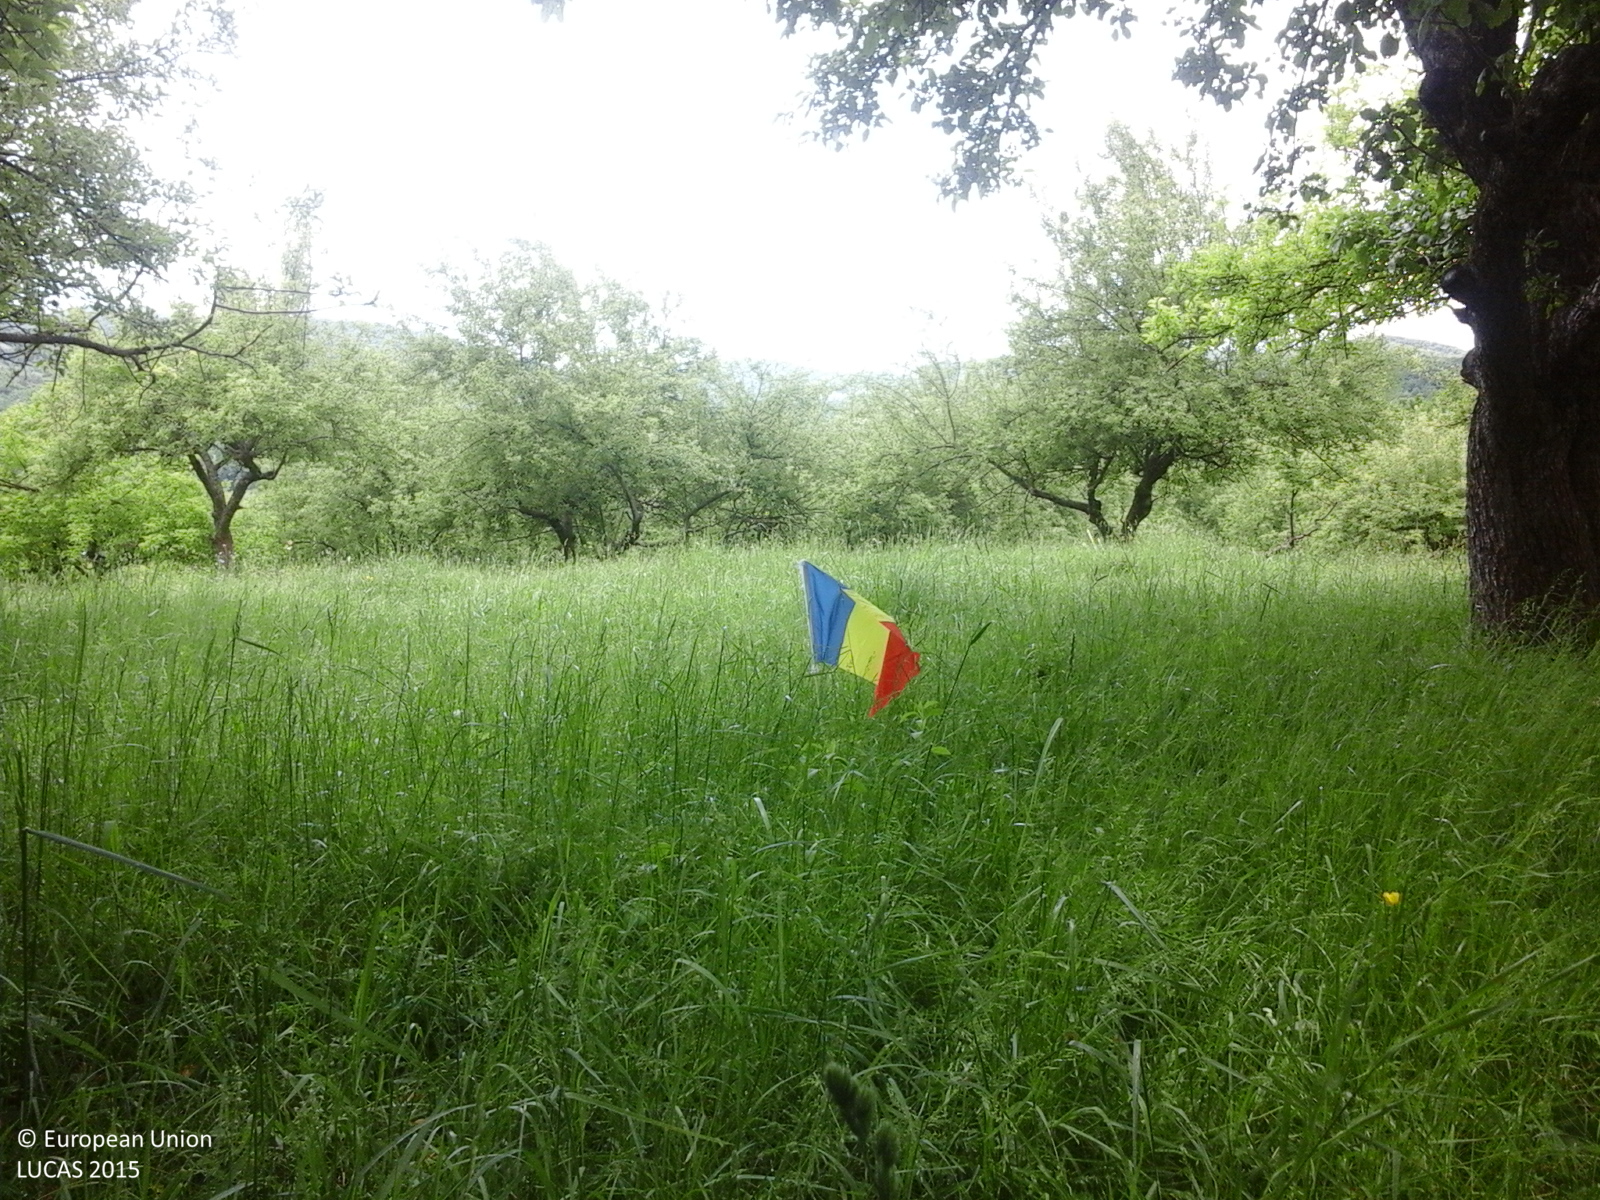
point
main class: Cropland
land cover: Apple fruit
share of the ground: > 75 %
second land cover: Grassland without tree/shrub cover
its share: 50 - 75 %
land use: Agriculture (excluding fallow land and kitchen gardens)
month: May
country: RO
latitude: 45.2396
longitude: 26.2834
